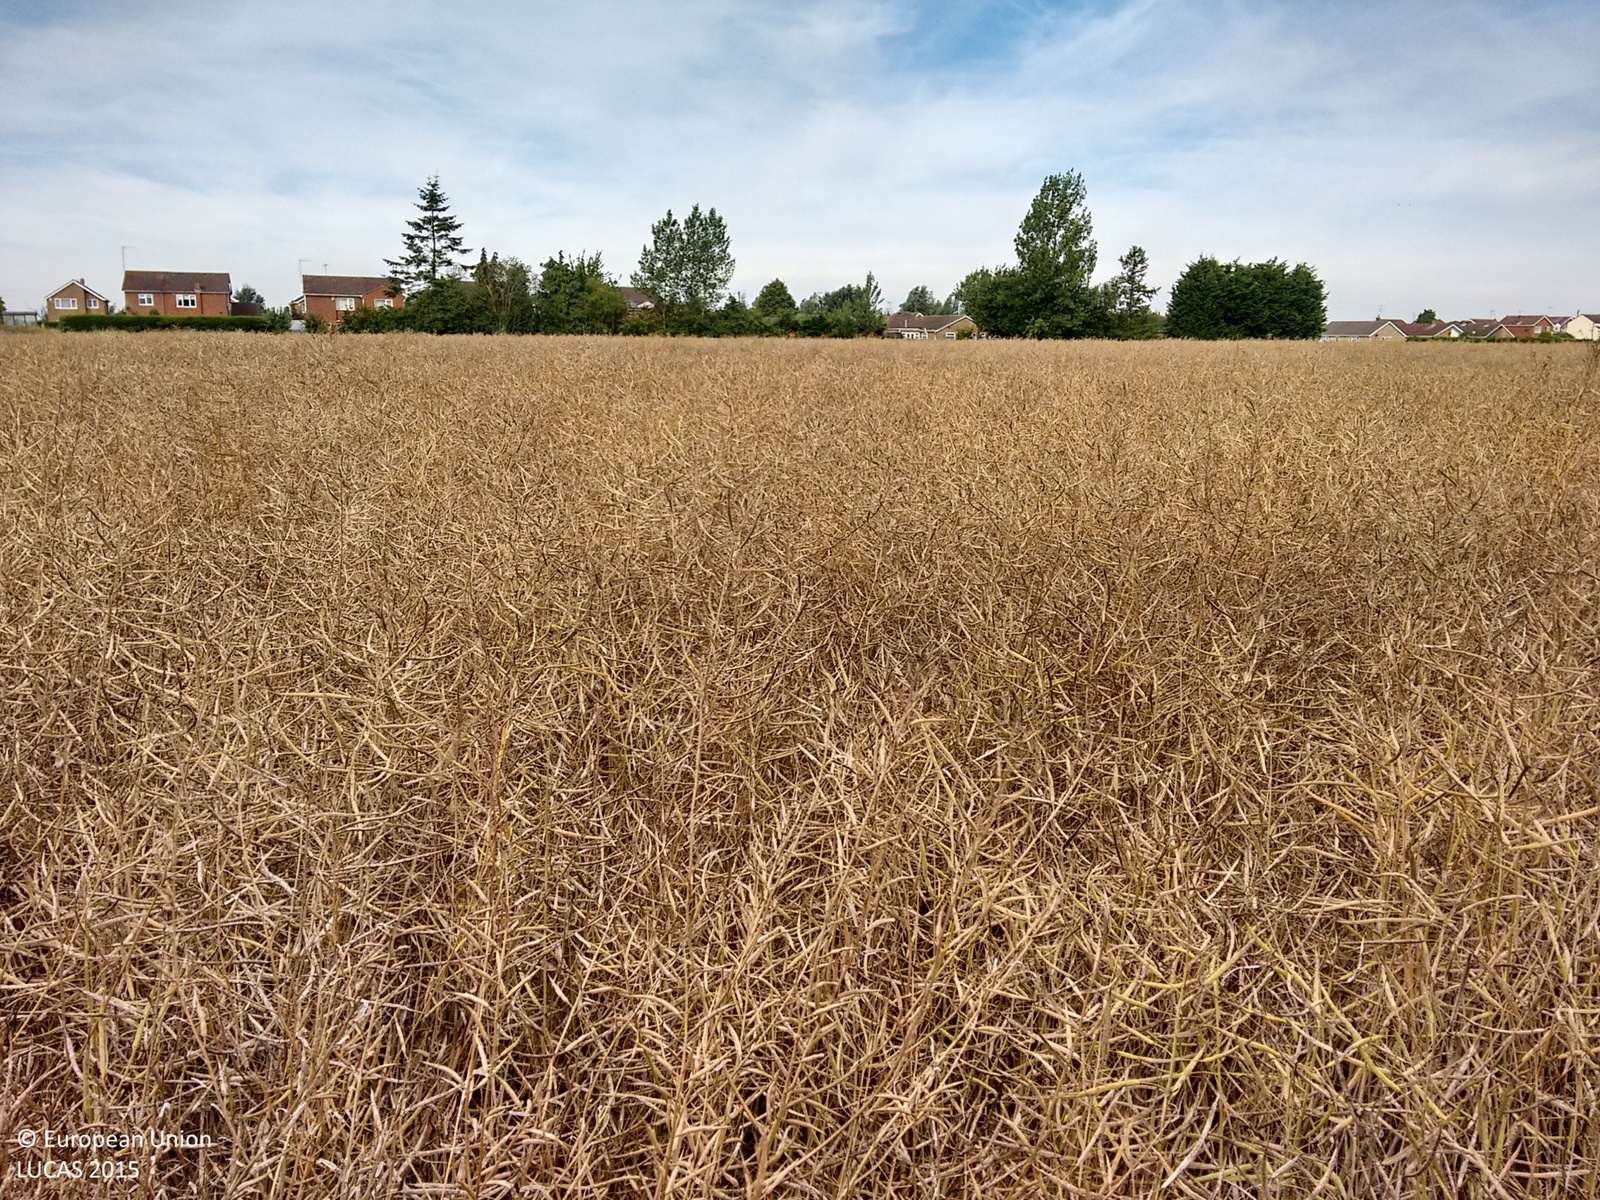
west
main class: Cropland
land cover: Rape and turnip rape
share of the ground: > 75 %
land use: Agriculture (excluding fallow land and kitchen gardens)
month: August
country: GB
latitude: 52.7601
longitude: 0.3241
